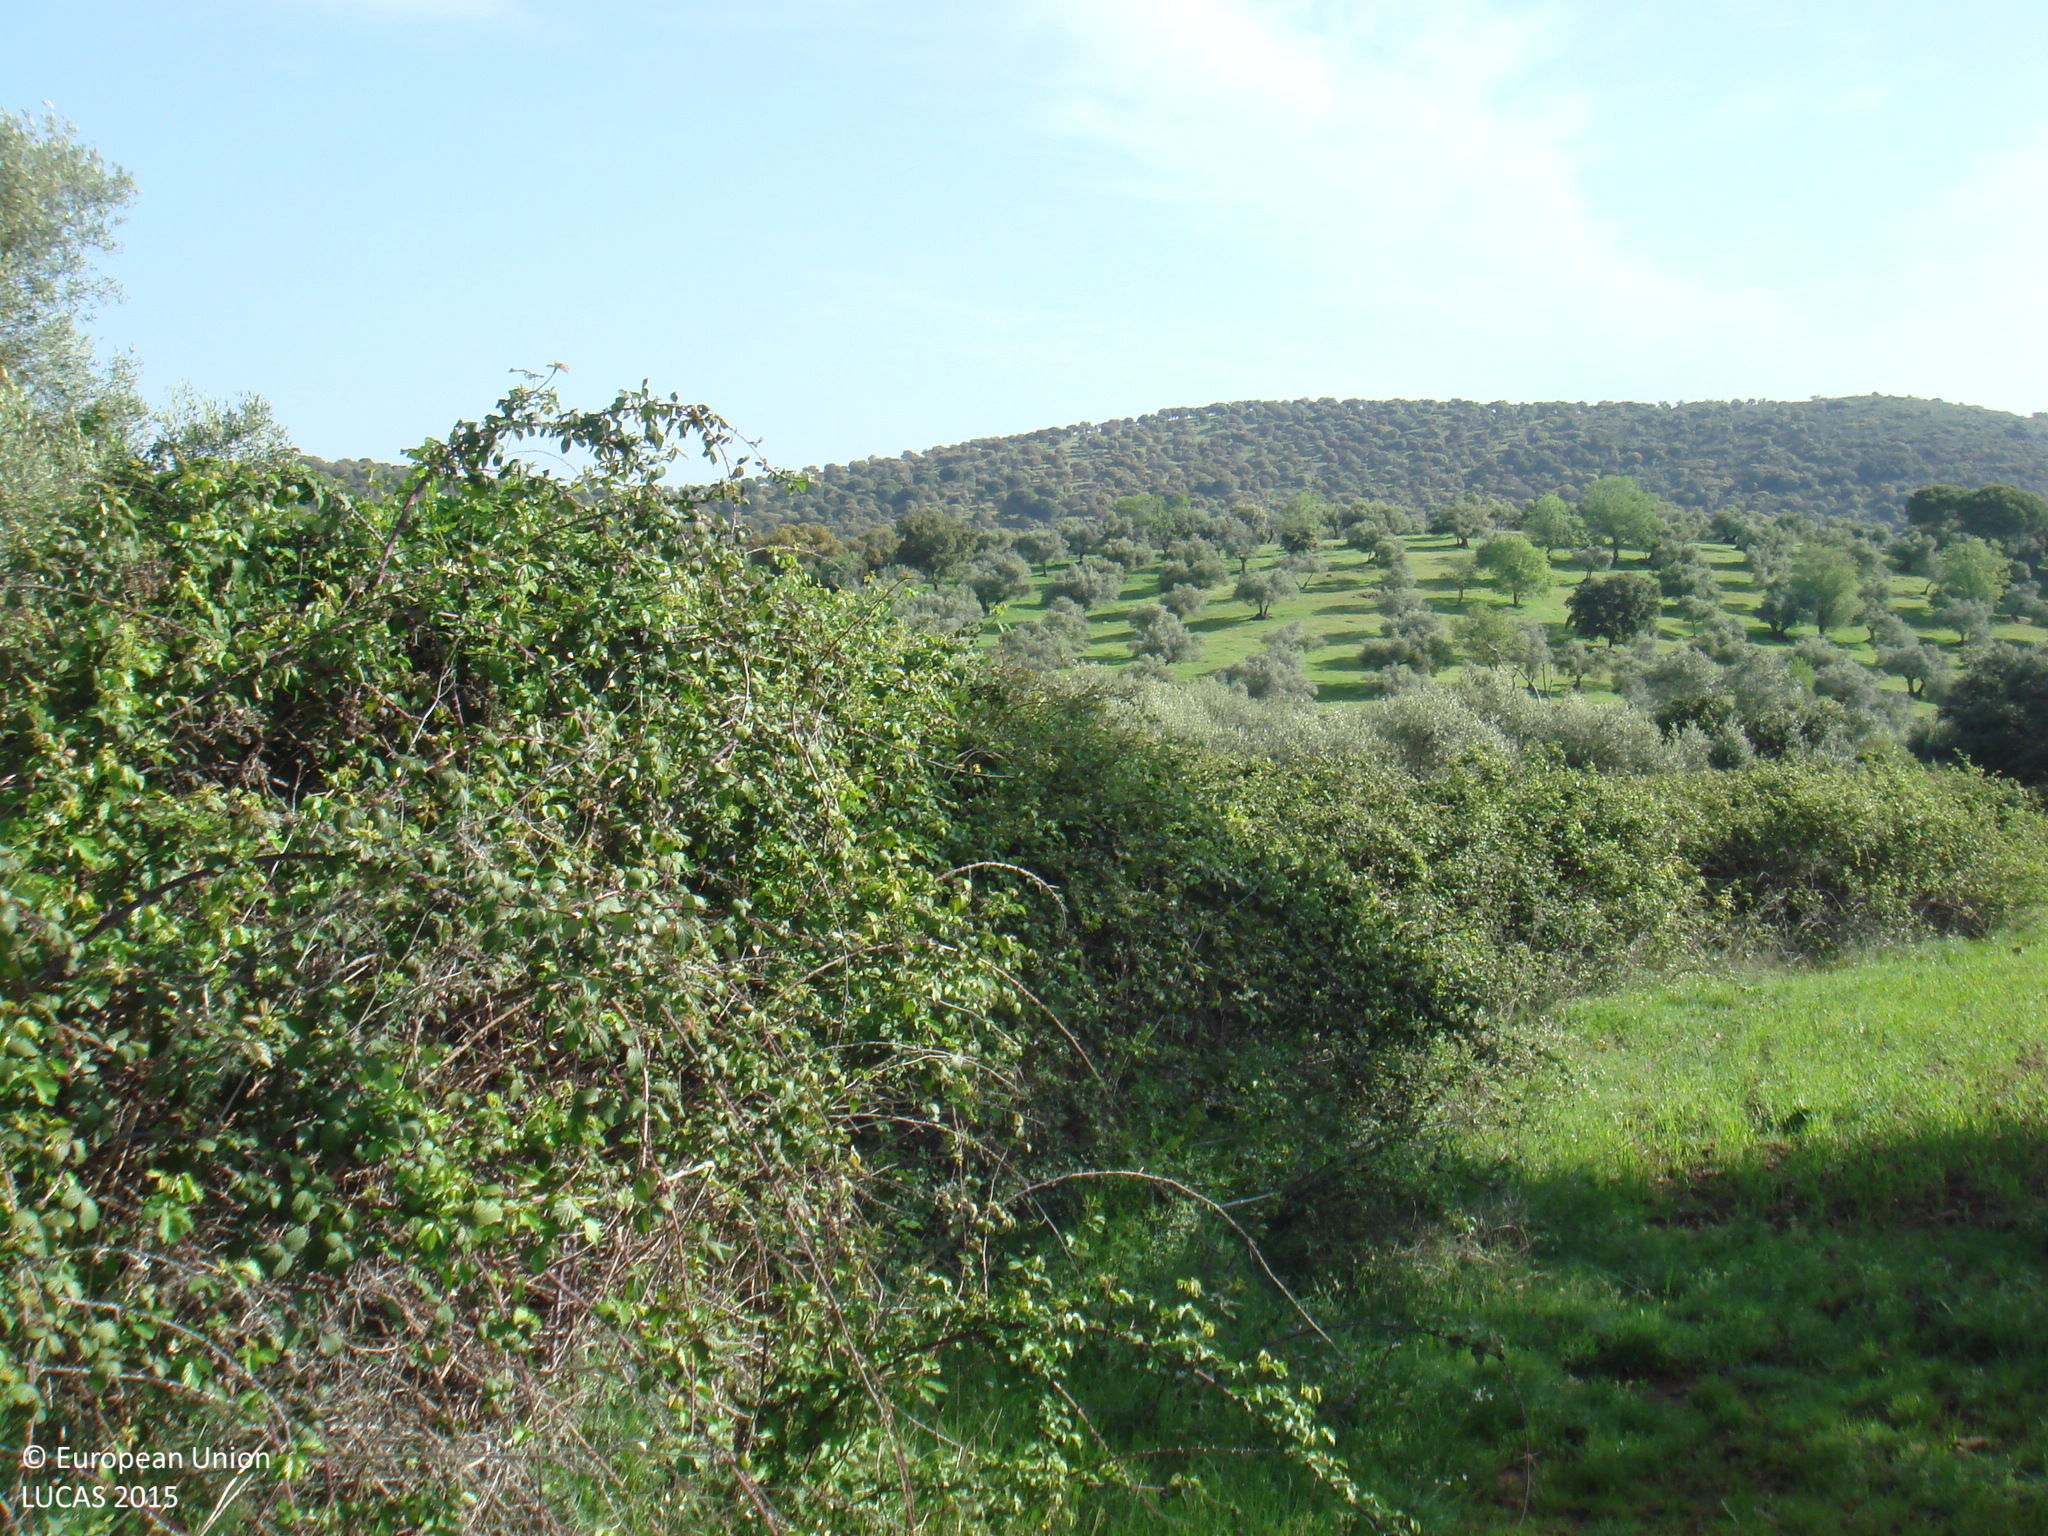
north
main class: Cropland
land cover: Oats
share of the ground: > 75 %
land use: Agriculture (excluding fallow land and kitchen gardens)
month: April
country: ES
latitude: 38.1042
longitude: -5.0641
